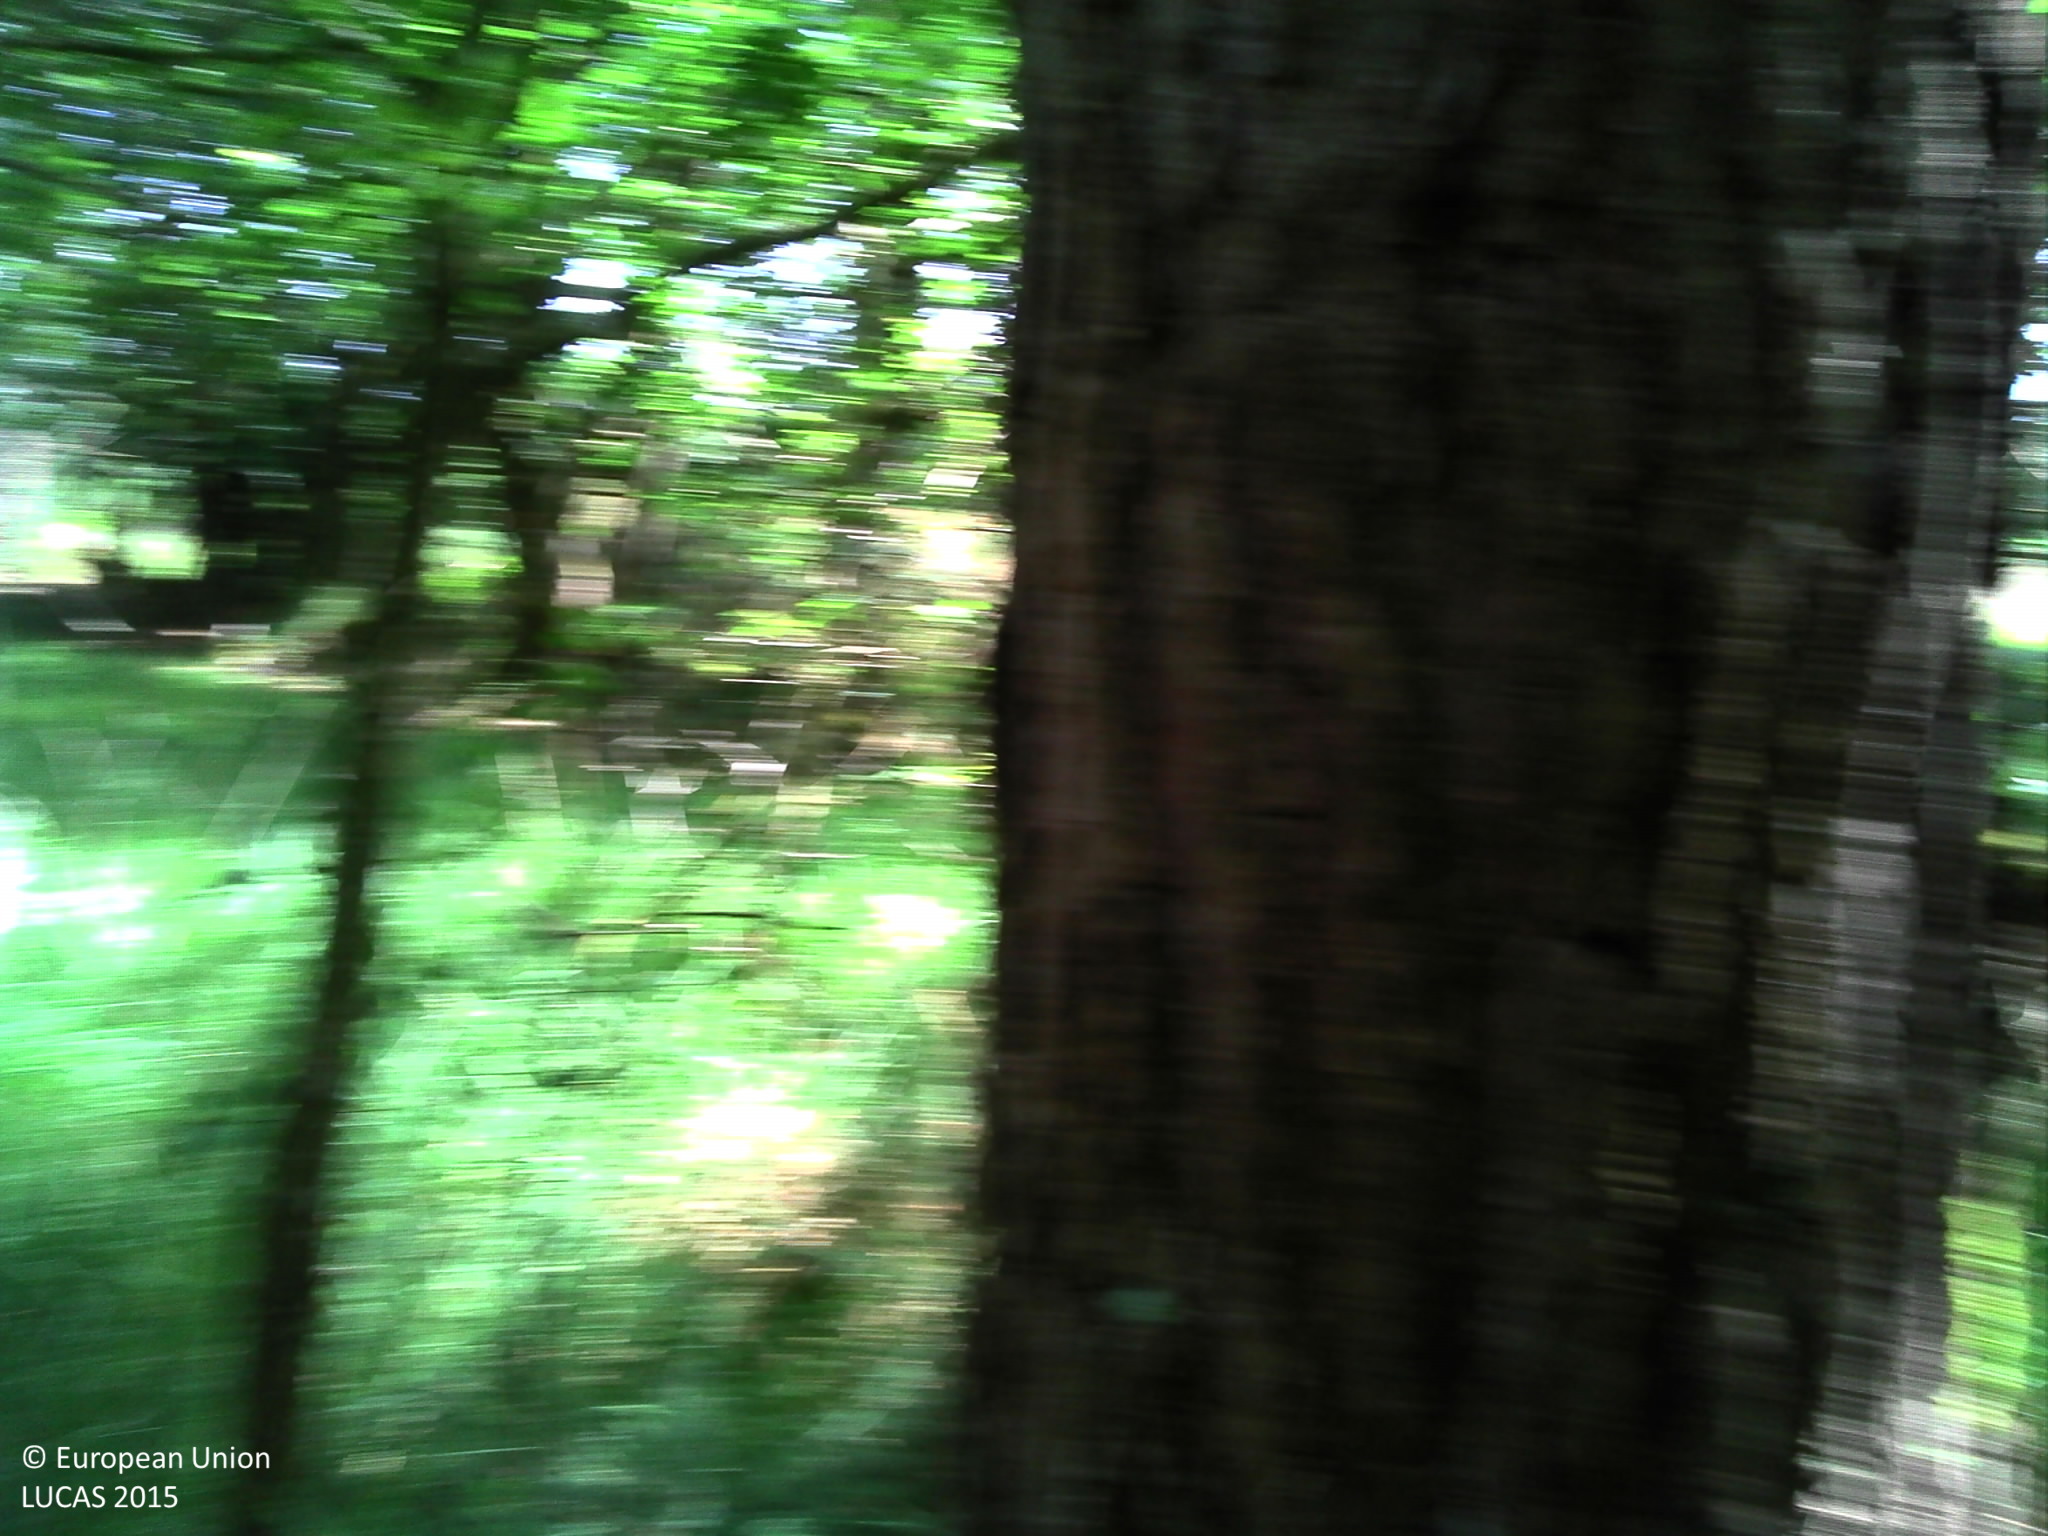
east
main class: Woodland
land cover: Broadleaved woodland
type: acidophilous oak and oak-birch forest
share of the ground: > 75 %
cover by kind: broadleaved forest trees 70 %, herbaceous plants 30 %
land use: Forestry
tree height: > 5 m
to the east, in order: Broadleaved woodland; Spontaneously vegetated surfaces; Broadleaved woodland
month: June
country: FR
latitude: 48.0676
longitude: -2.0642
